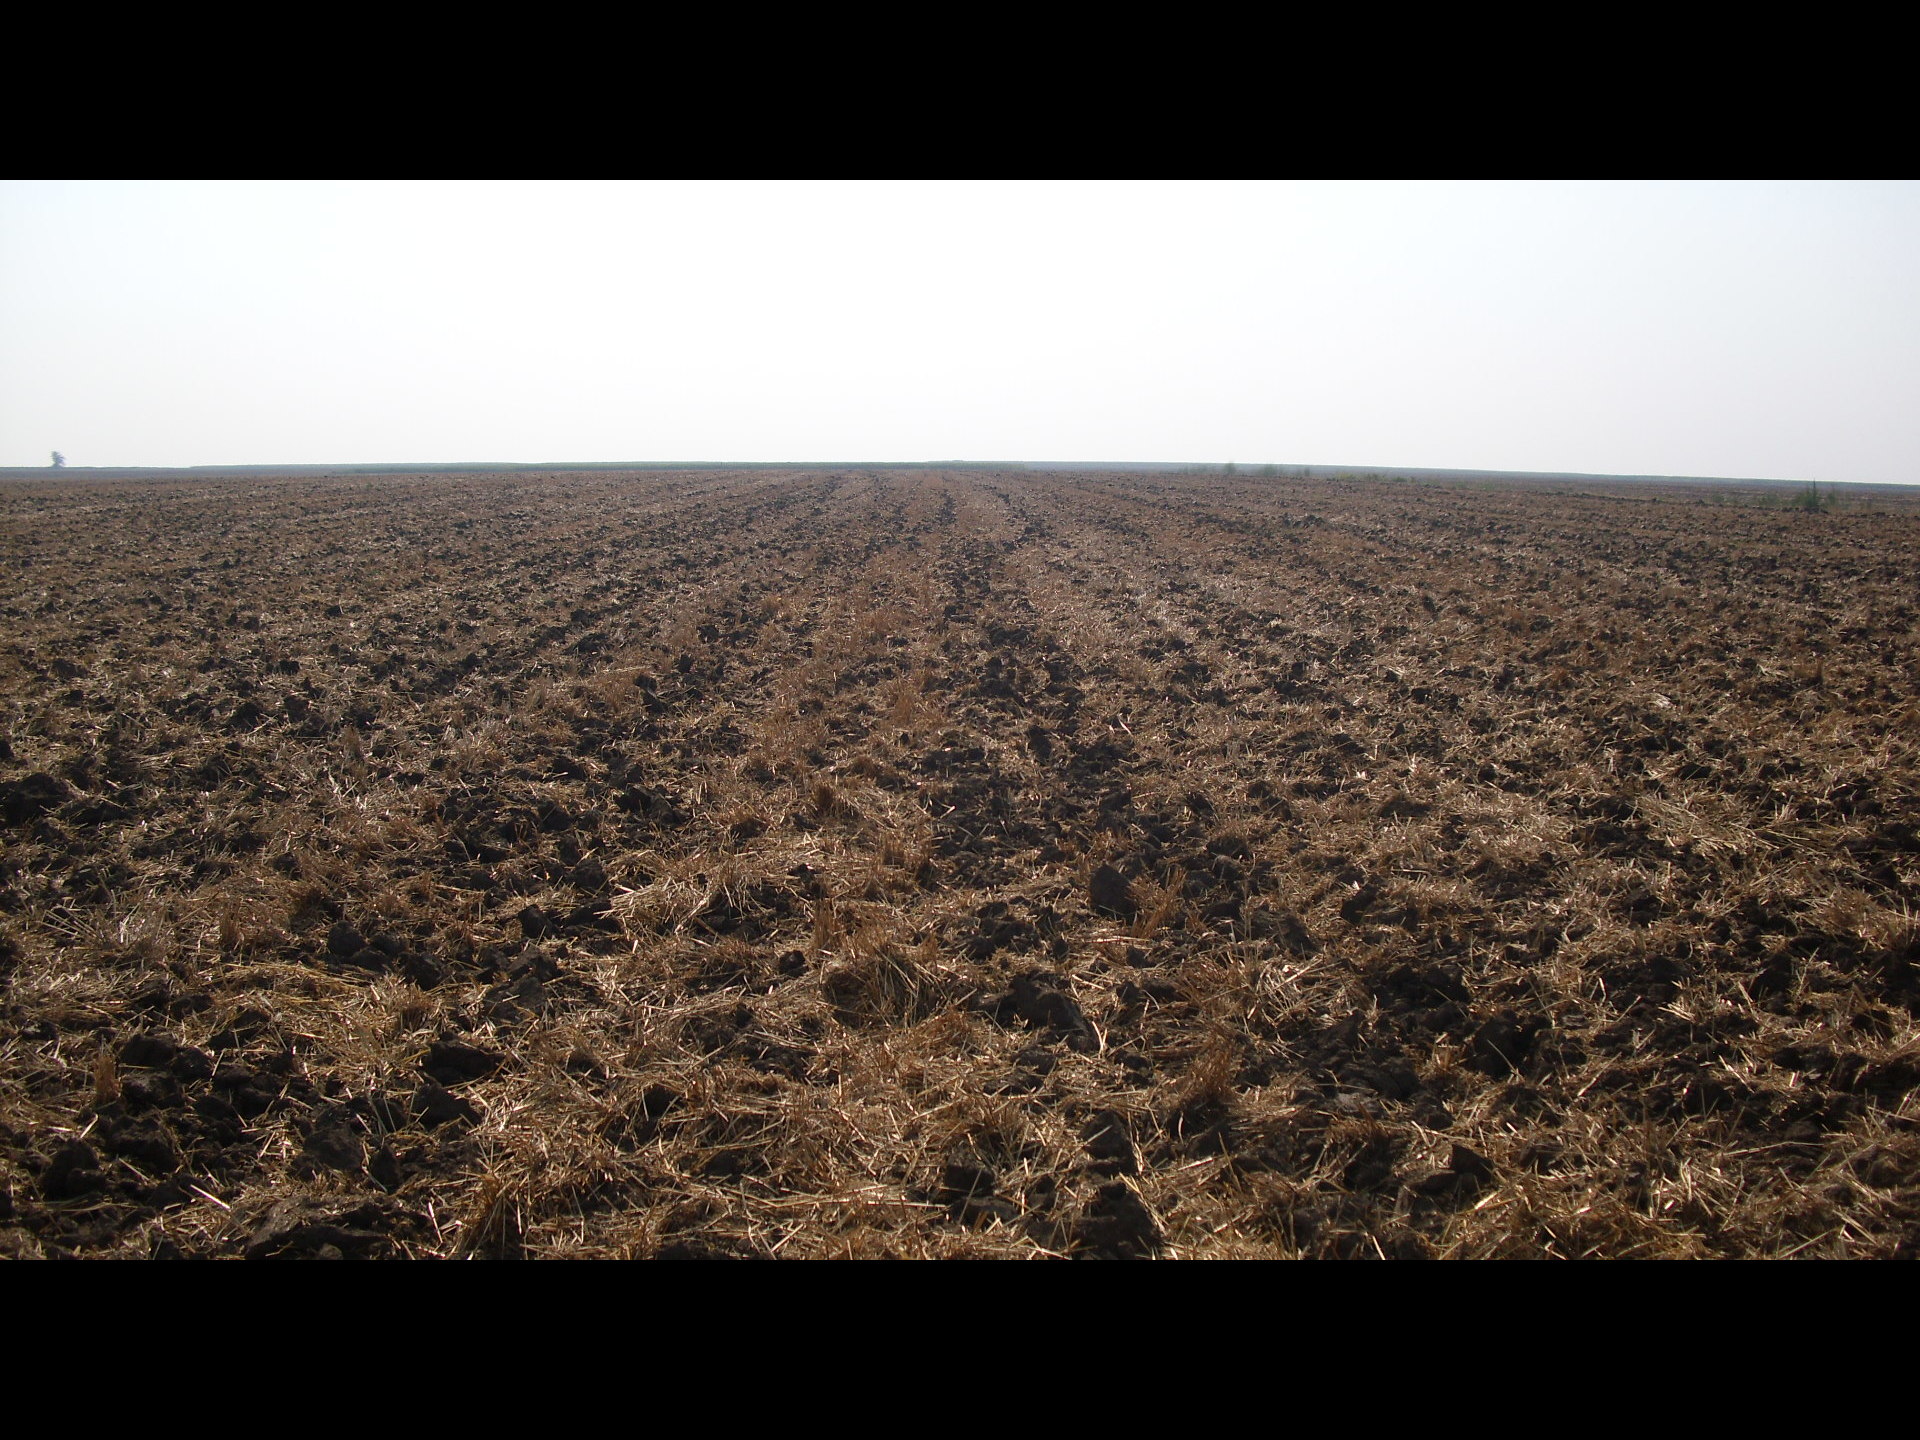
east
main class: Cropland
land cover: Barley
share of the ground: 50 - 75 %
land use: Agriculture (excluding fallow land and kitchen gardens)
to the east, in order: Barley
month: July
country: BG
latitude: 43.7176
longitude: 23.5140
